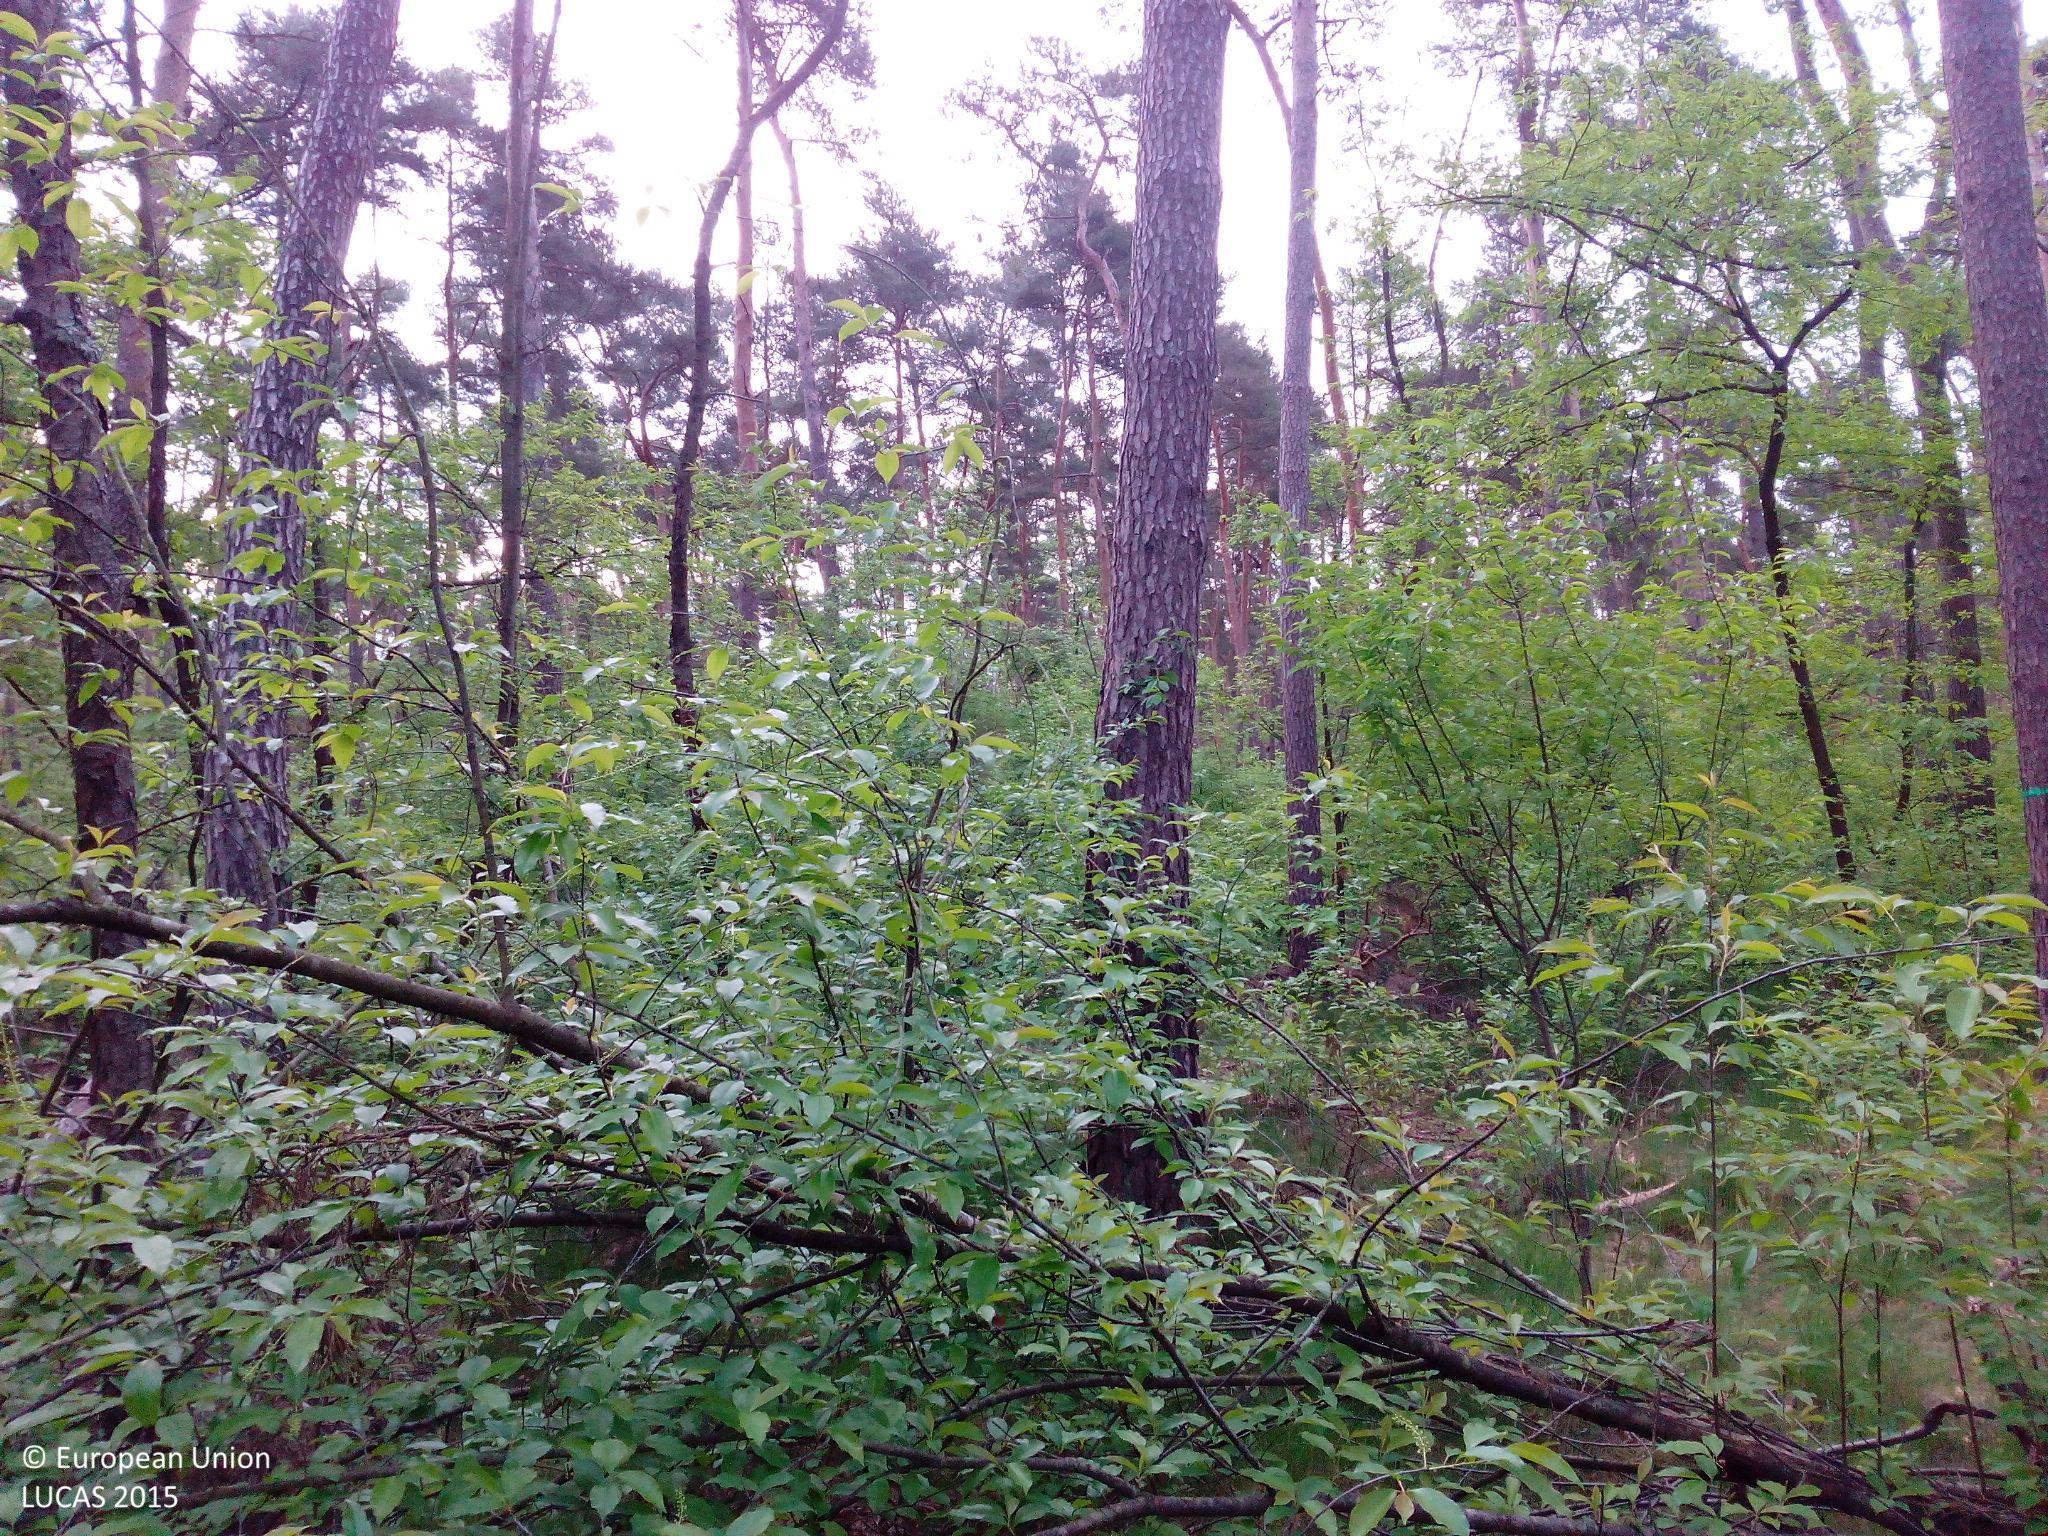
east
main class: Woodland
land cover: Pine dominated mixed woodland
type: hemiboreal forest and nemoral coniferous forest and mixed broadleaved-coniferous forest
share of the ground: 50 - 75 %
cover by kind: coniferous forest trees 45 %, broadleaved forest trees 25 %, herbaceous plants 25 %, shrubs 5 %
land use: Forestry
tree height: > 5 m
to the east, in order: Pine dominated mixed woodland; Tracks; Pine dominated mixed woodland
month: May
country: DE
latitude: 49.6170
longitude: 8.5194
